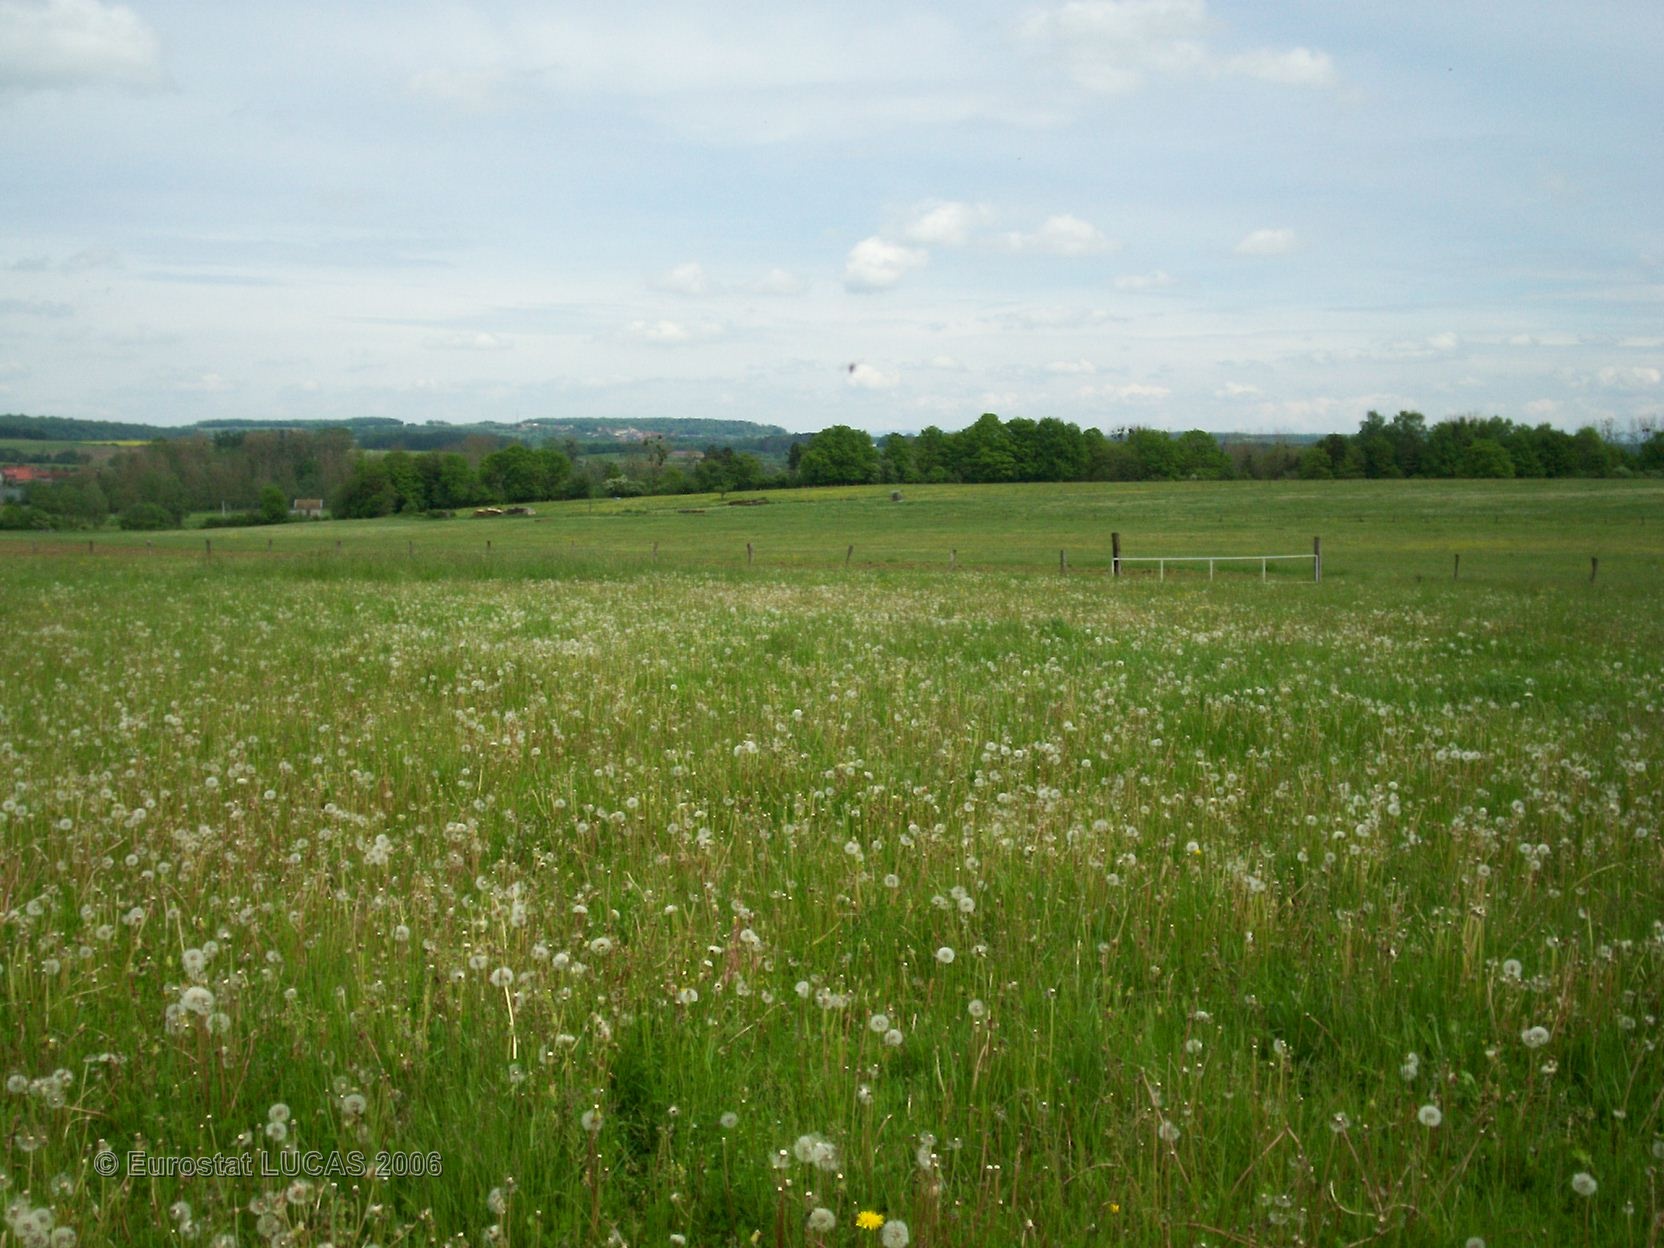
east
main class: Grassland
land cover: Grassland without tree/shrub cover
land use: Agriculture (excluding fallow land and kitchen gardens)
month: May
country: FR
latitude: 48.4398
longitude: 6.5535
